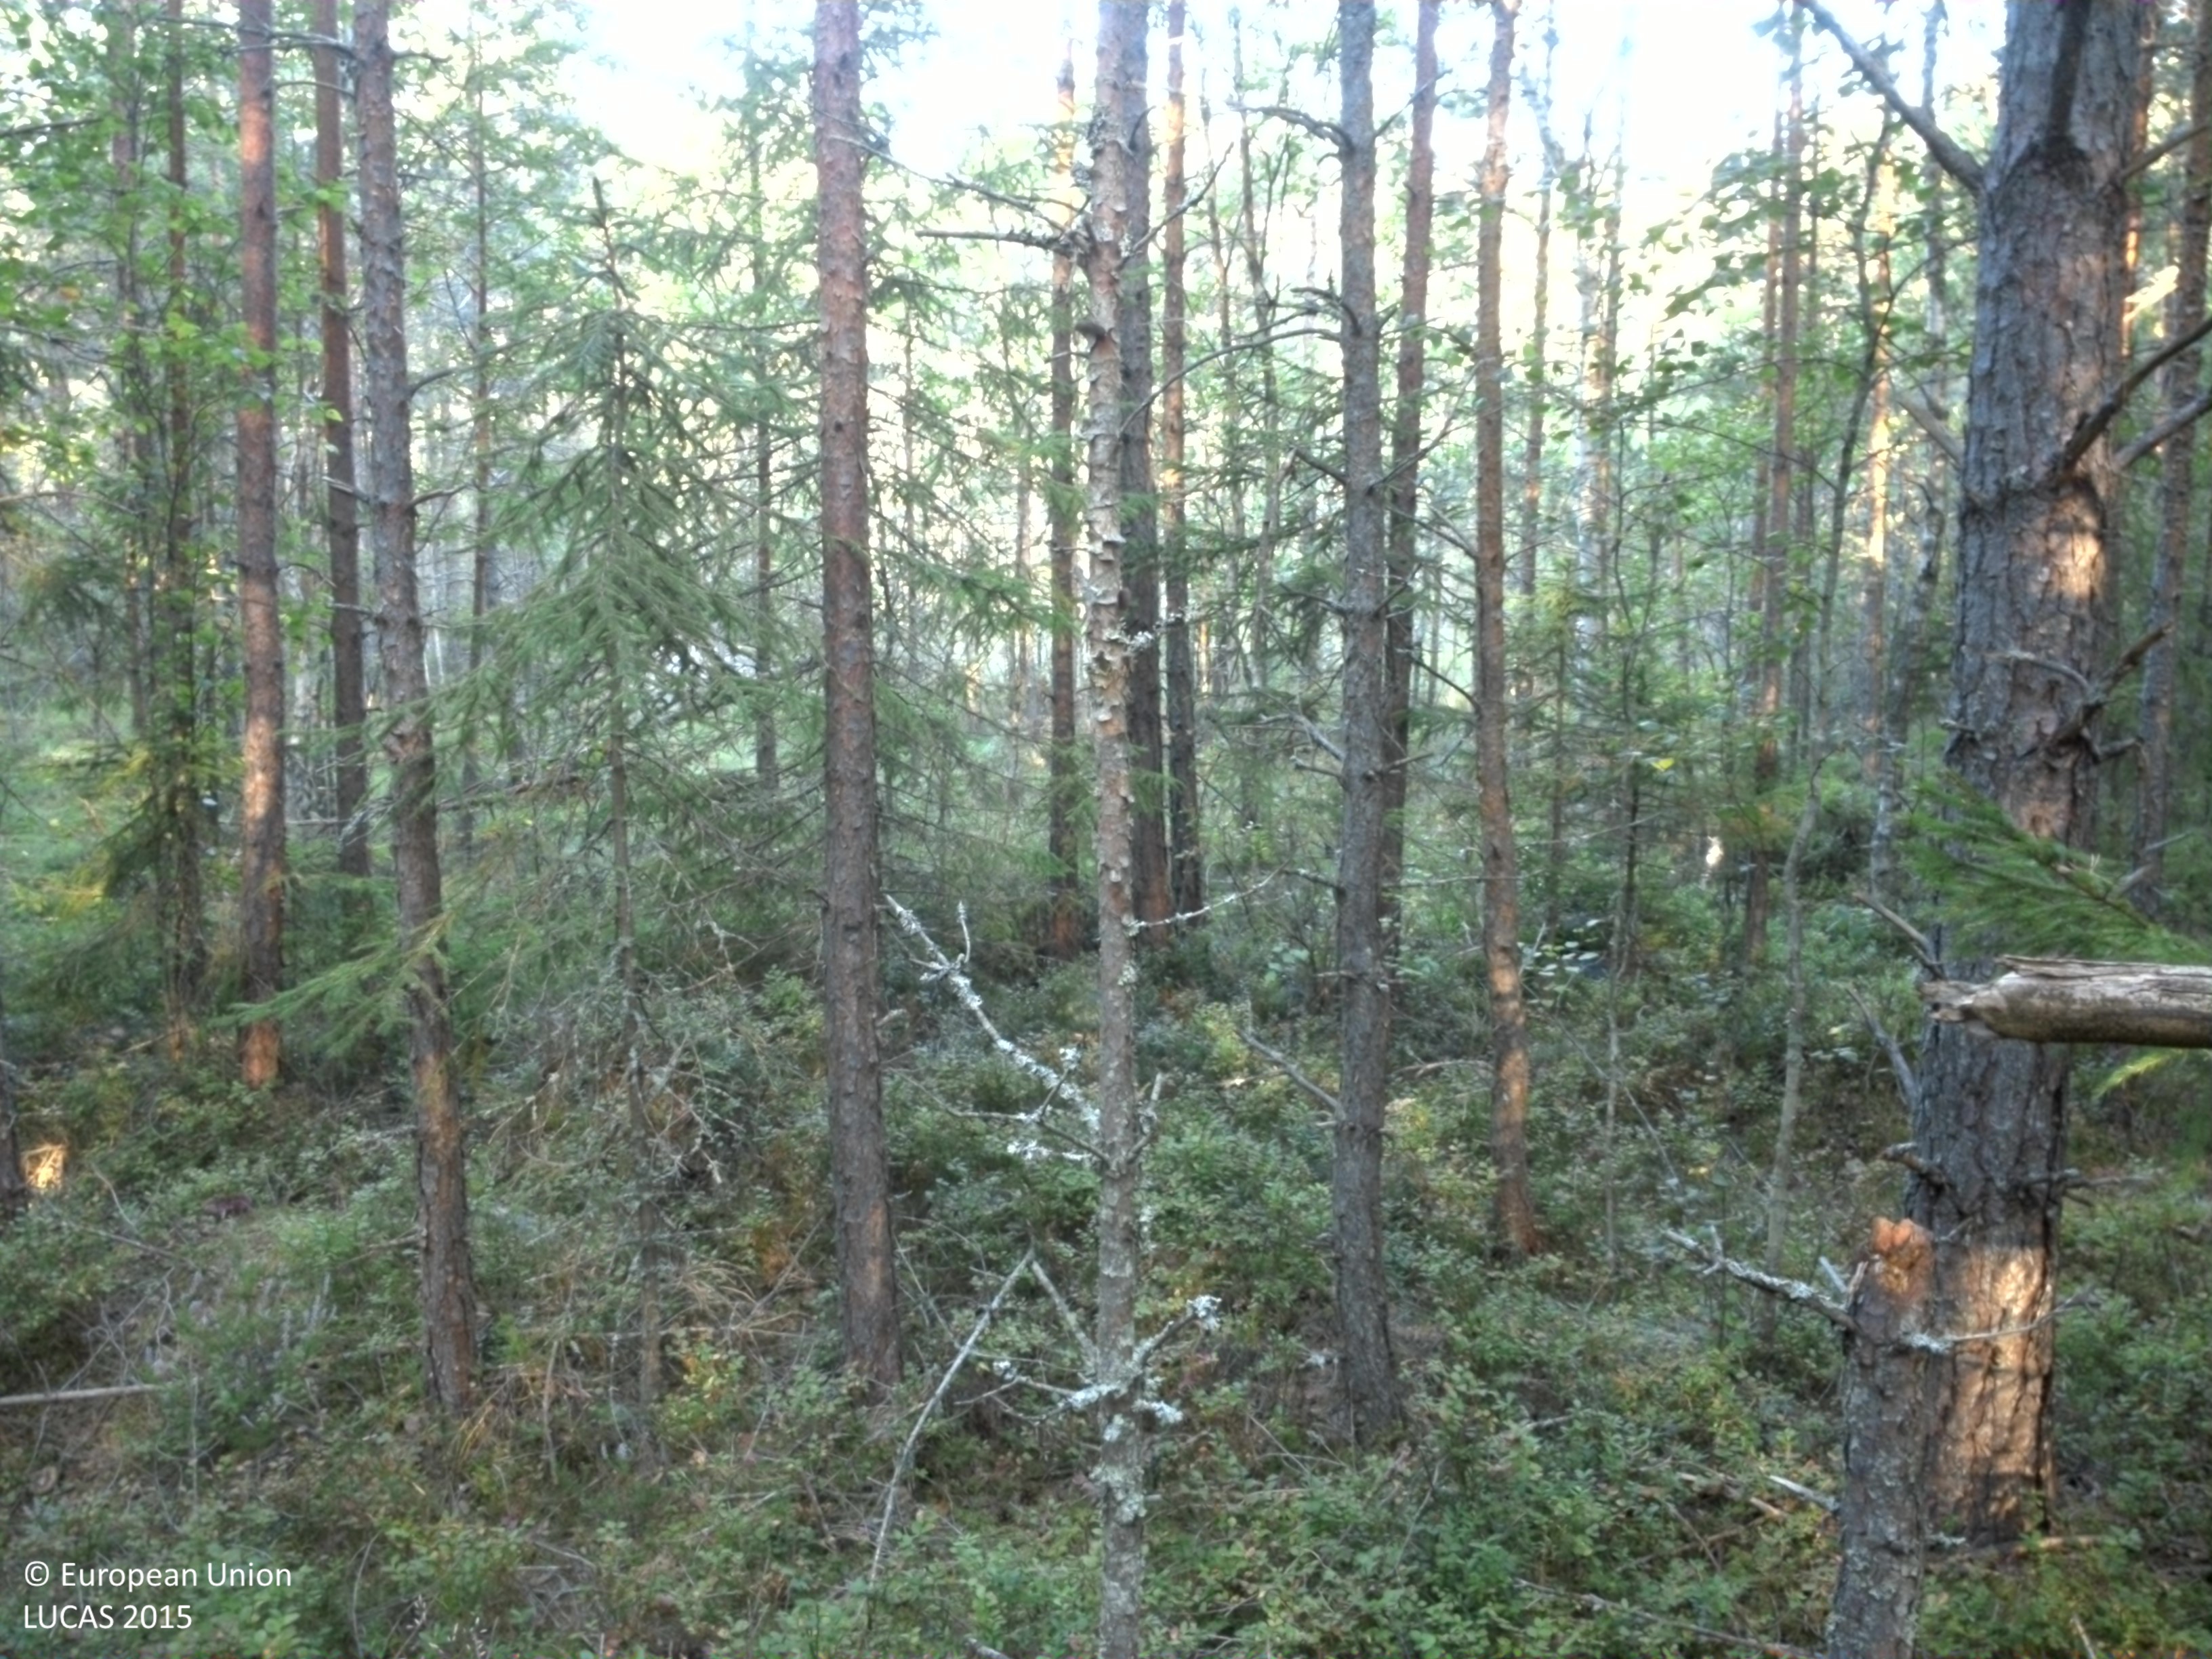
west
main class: Woodland
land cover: Pine dominated coniferous woodland
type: boreal forest
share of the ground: > 75 %
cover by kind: coniferous forest trees 75 %, lichens and mosses 15 %, shrubs 10 %
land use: Forestry
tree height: > 5 m
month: August
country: SE
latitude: 59.7287
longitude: 15.9843
